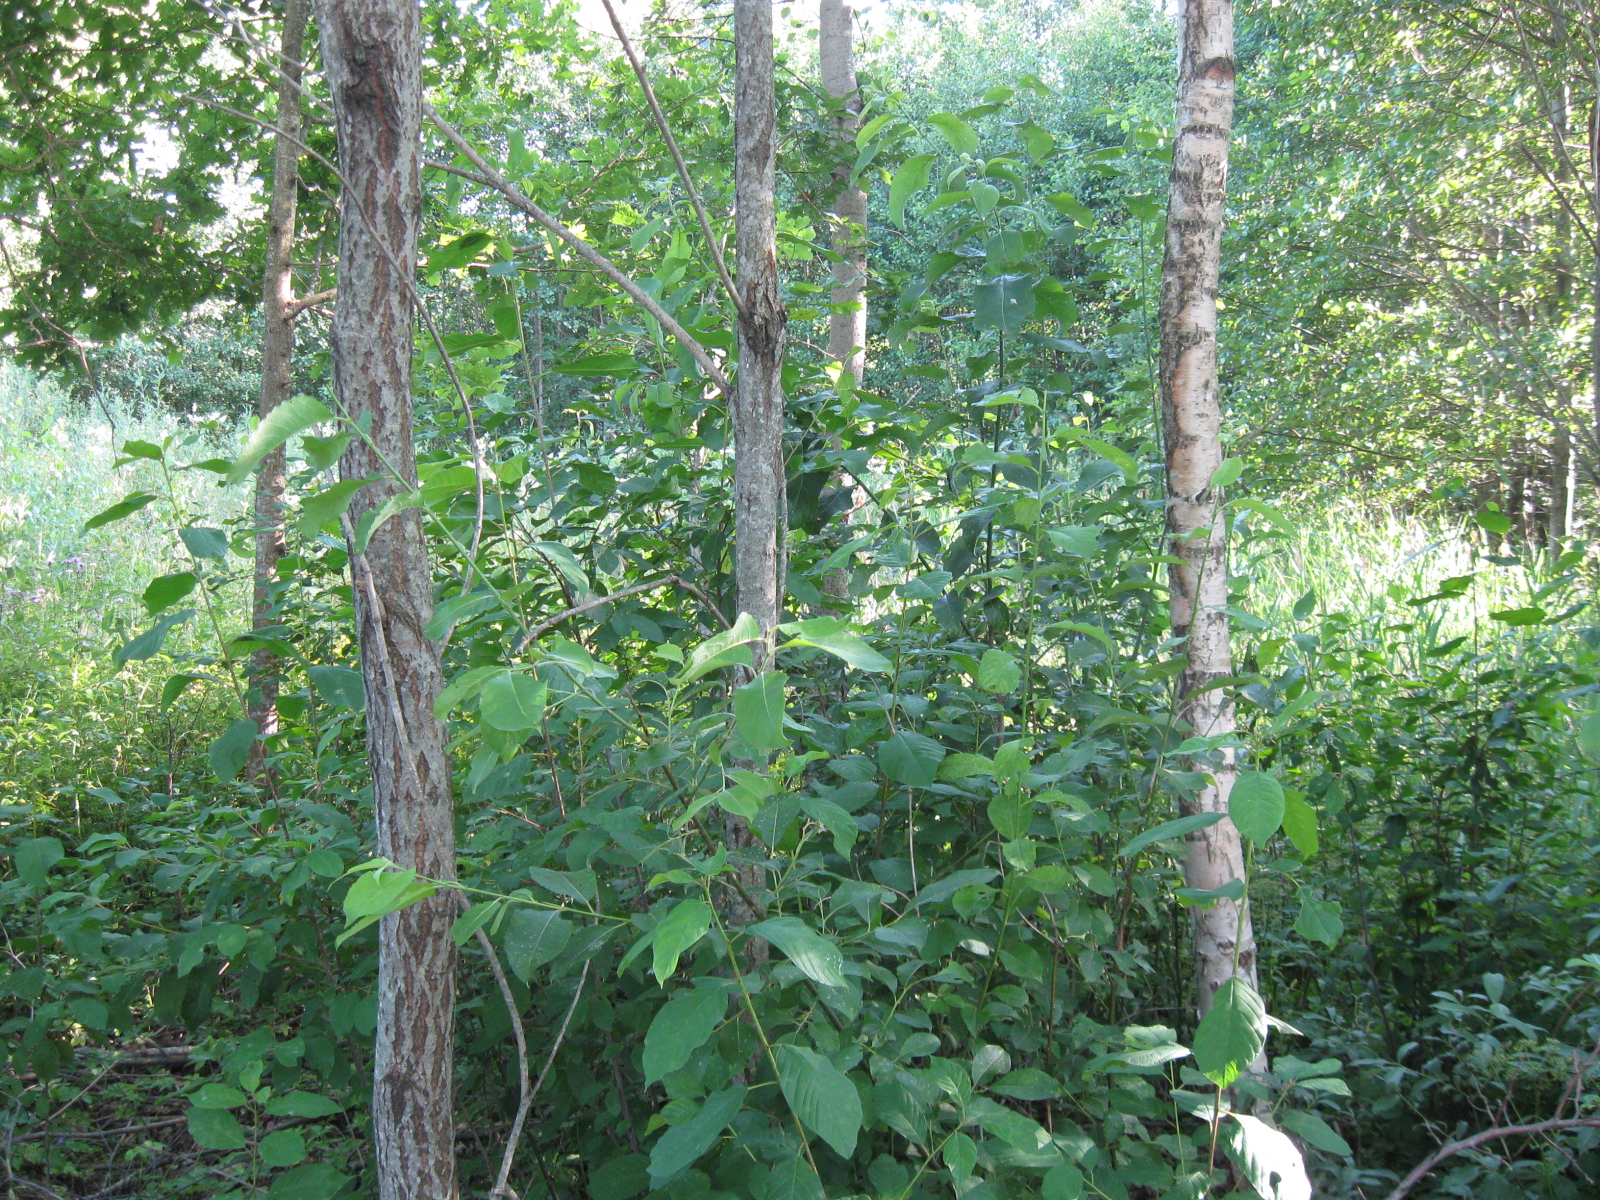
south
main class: Woodland
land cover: Broadleaved woodland
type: non-riverine alder, birch or aspen forest
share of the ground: > 75 %
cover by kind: broadleaved forest trees 90 %, herbaceous plants 10 %
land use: Forestry
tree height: > 5 m
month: July
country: LT
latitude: 54.4936
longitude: 24.3814
